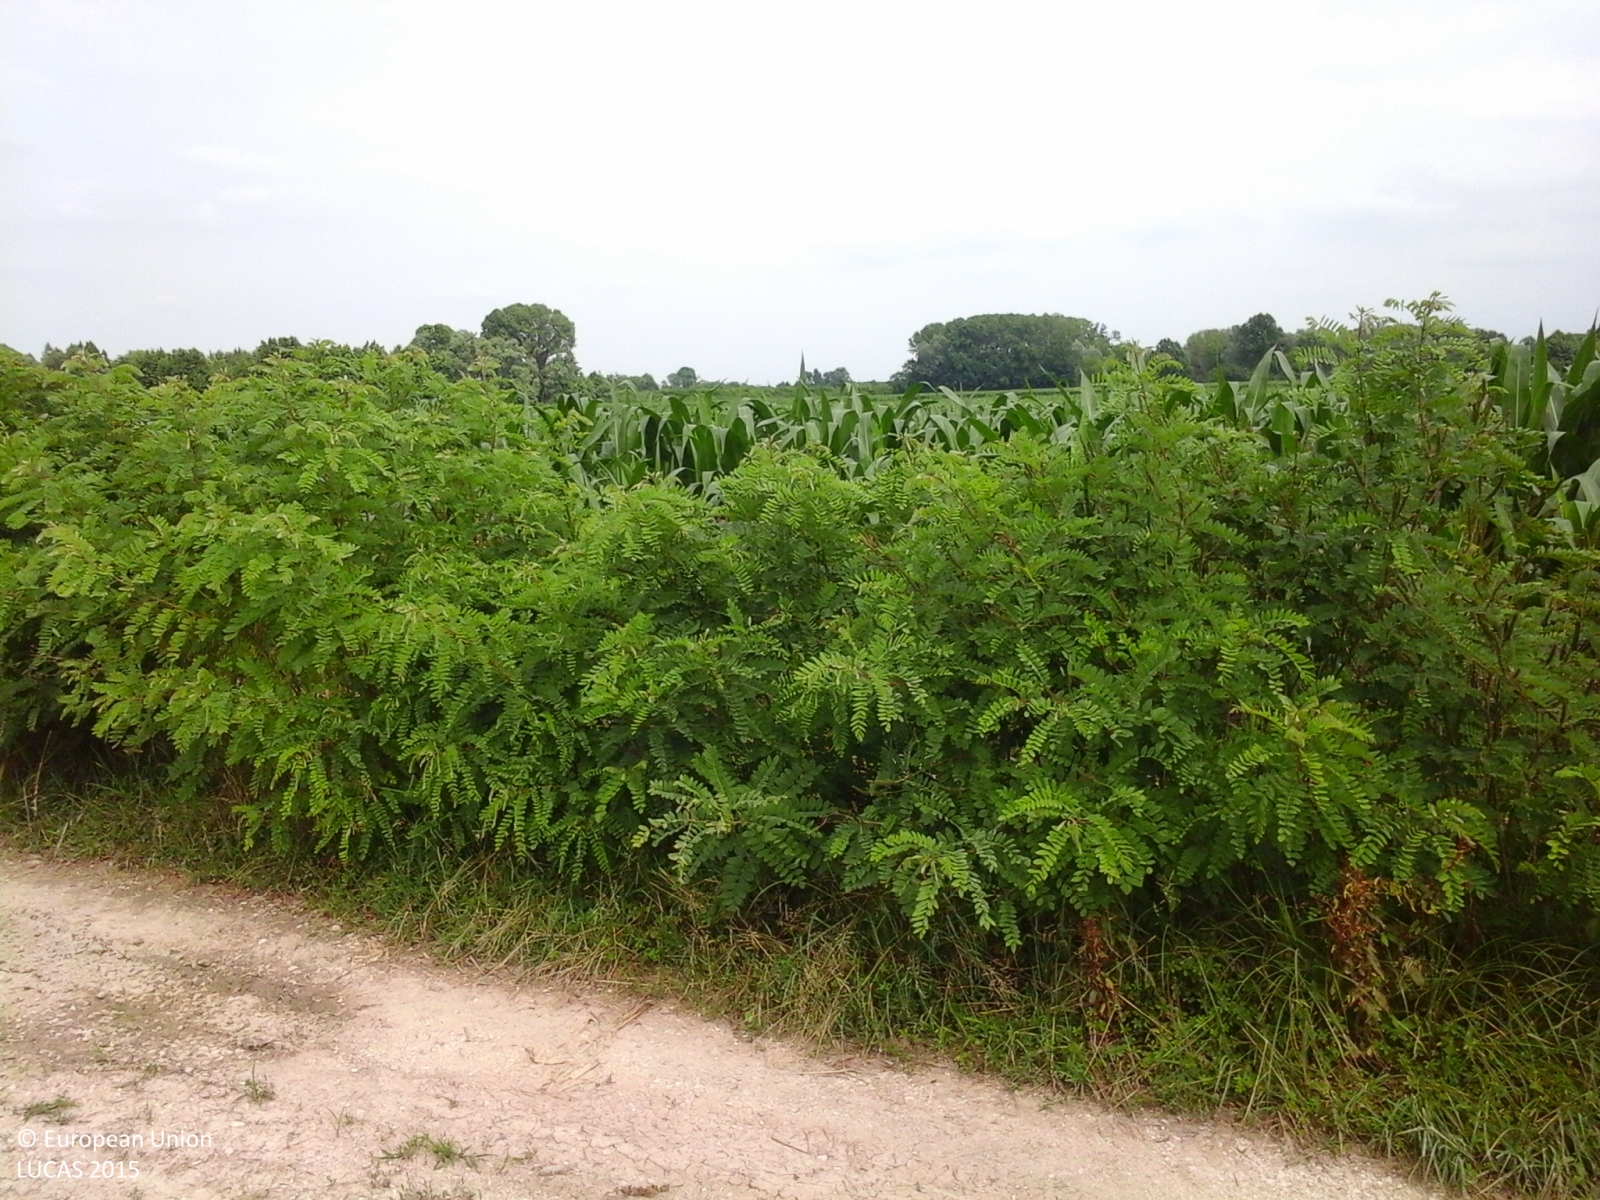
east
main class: Cropland
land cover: Maize
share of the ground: > 75 %
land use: Agriculture (excluding fallow land and kitchen gardens)
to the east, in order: Maize; Tracks; Managed hedges; Ditches and canals; Maize; Ditches and canals; Soya
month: June
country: IT
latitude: 45.8340
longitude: 12.5585
